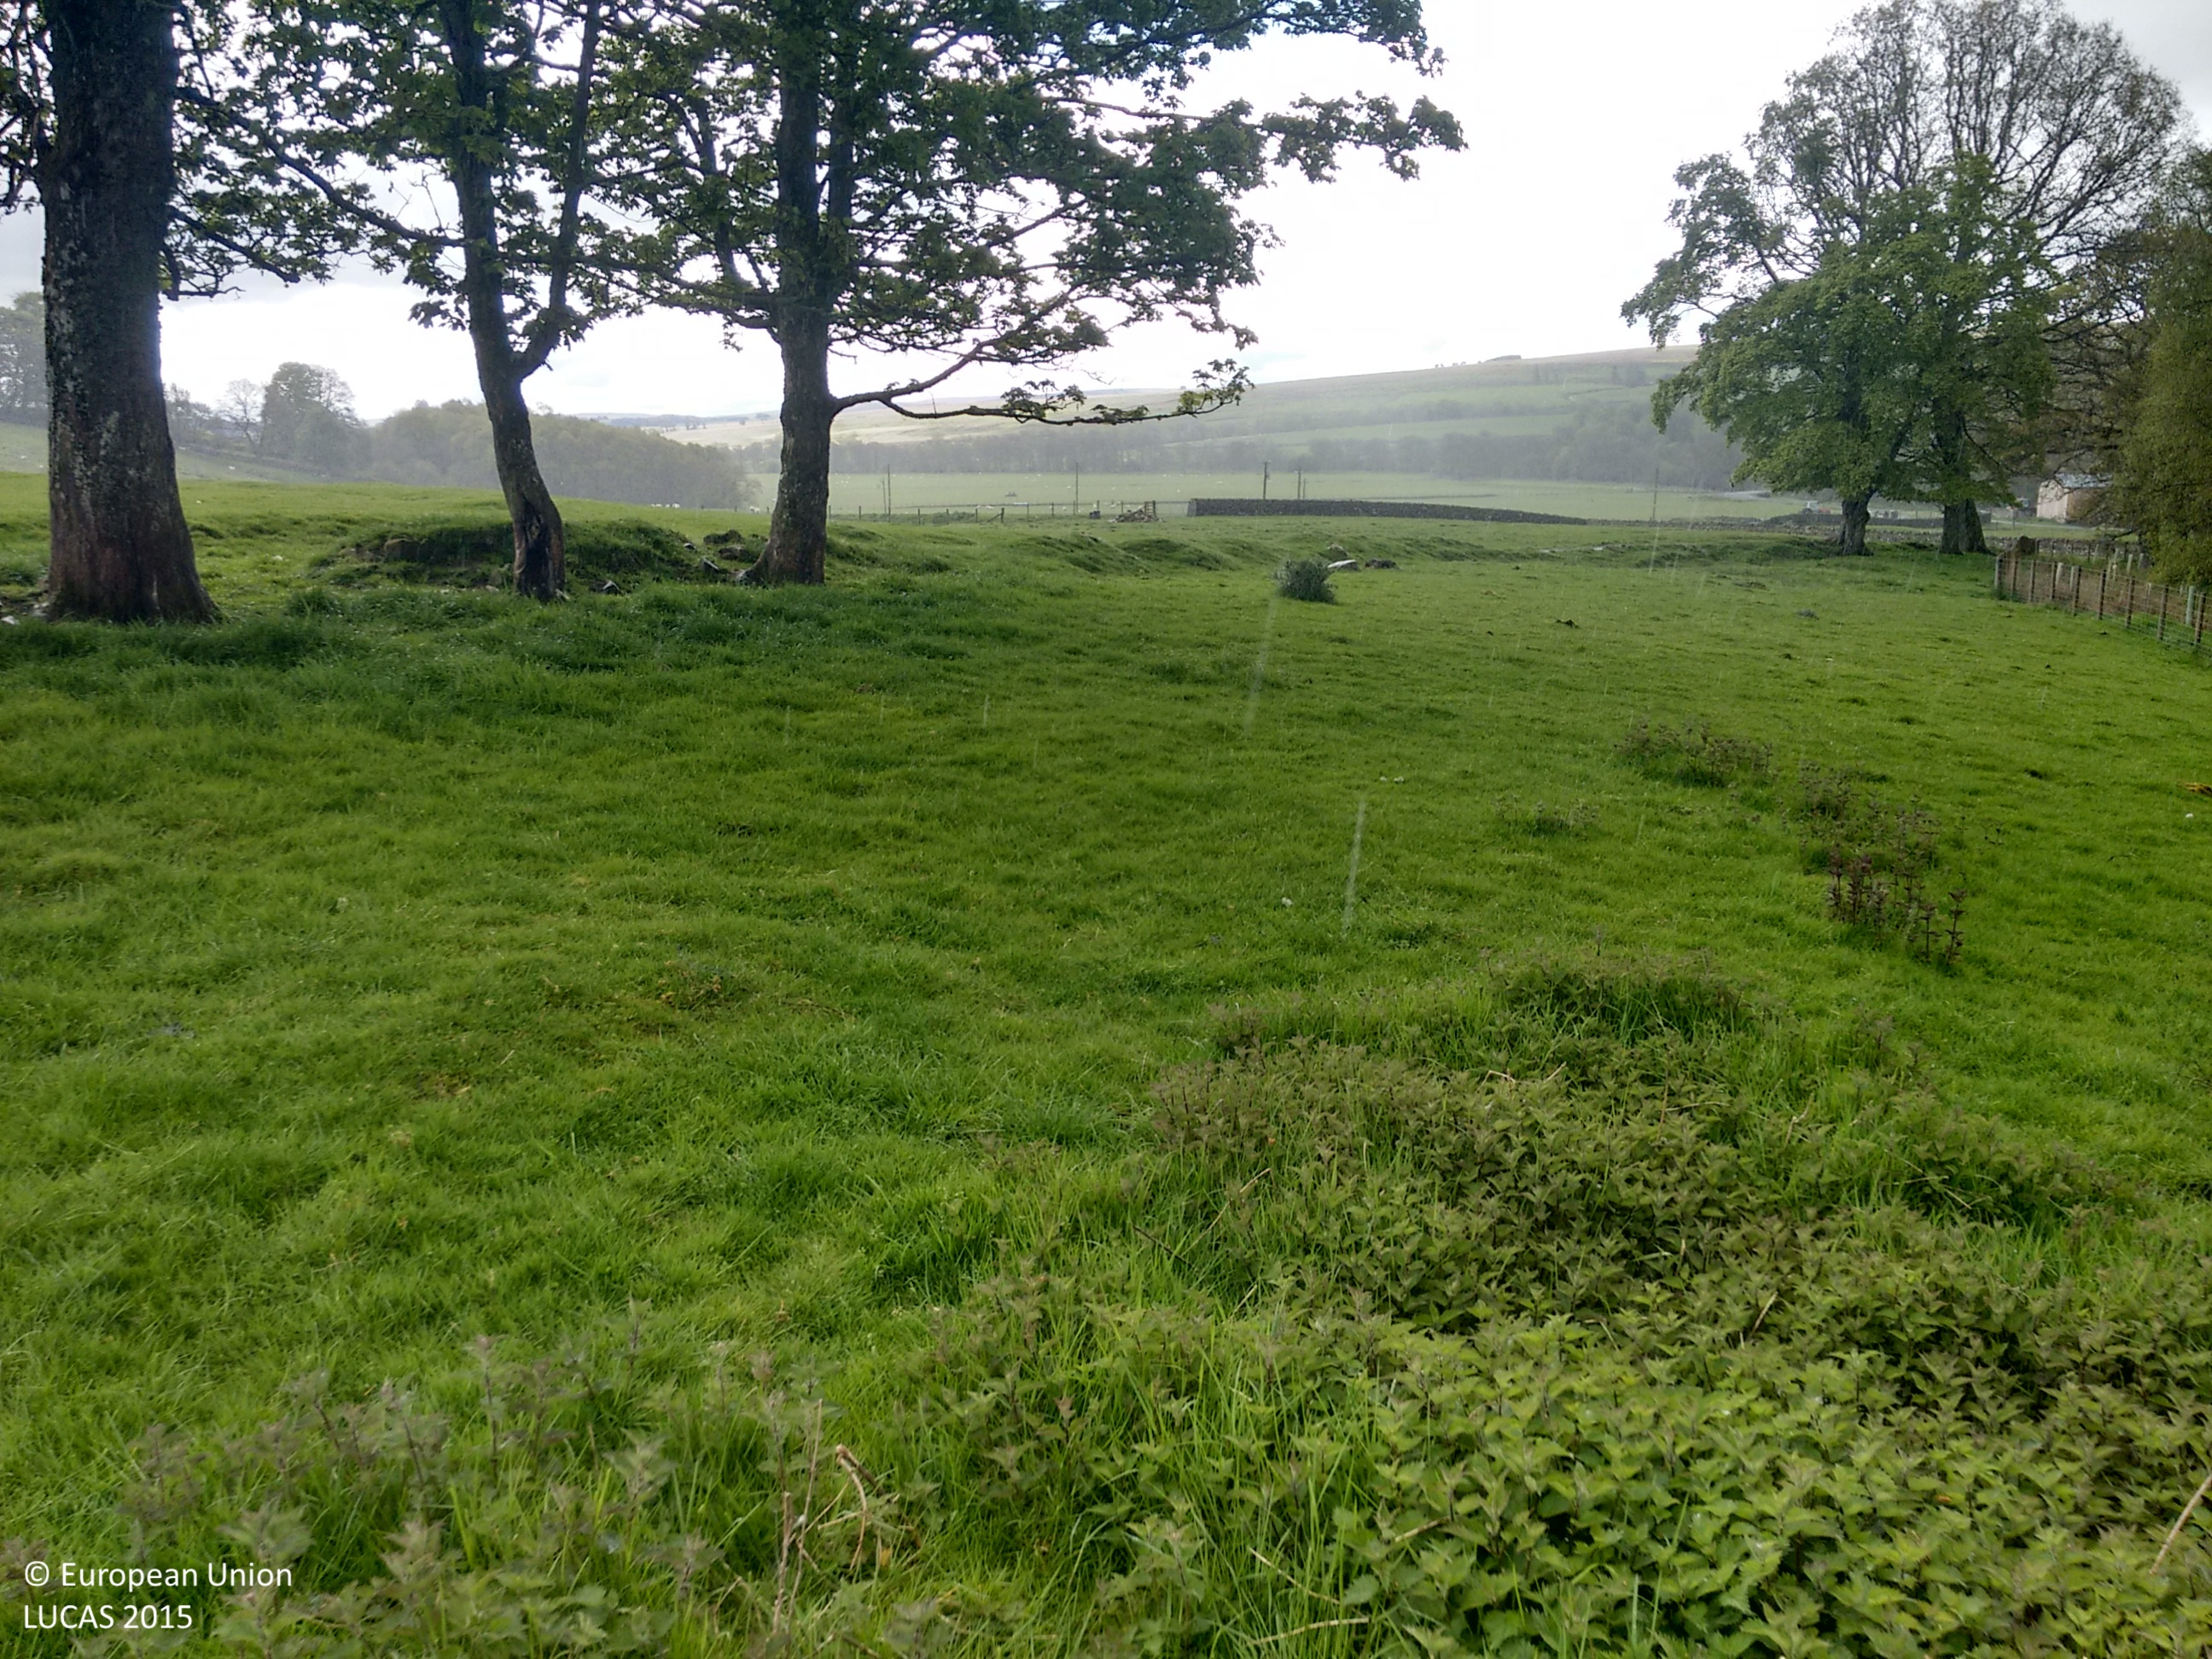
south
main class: Grassland
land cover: Grassland without tree/shrub cover
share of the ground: > 75 %
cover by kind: herbaceous plants 100 %
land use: Agriculture (excluding fallow land and kitchen gardens)
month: May
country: GB
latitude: 55.2699
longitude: -2.2554
